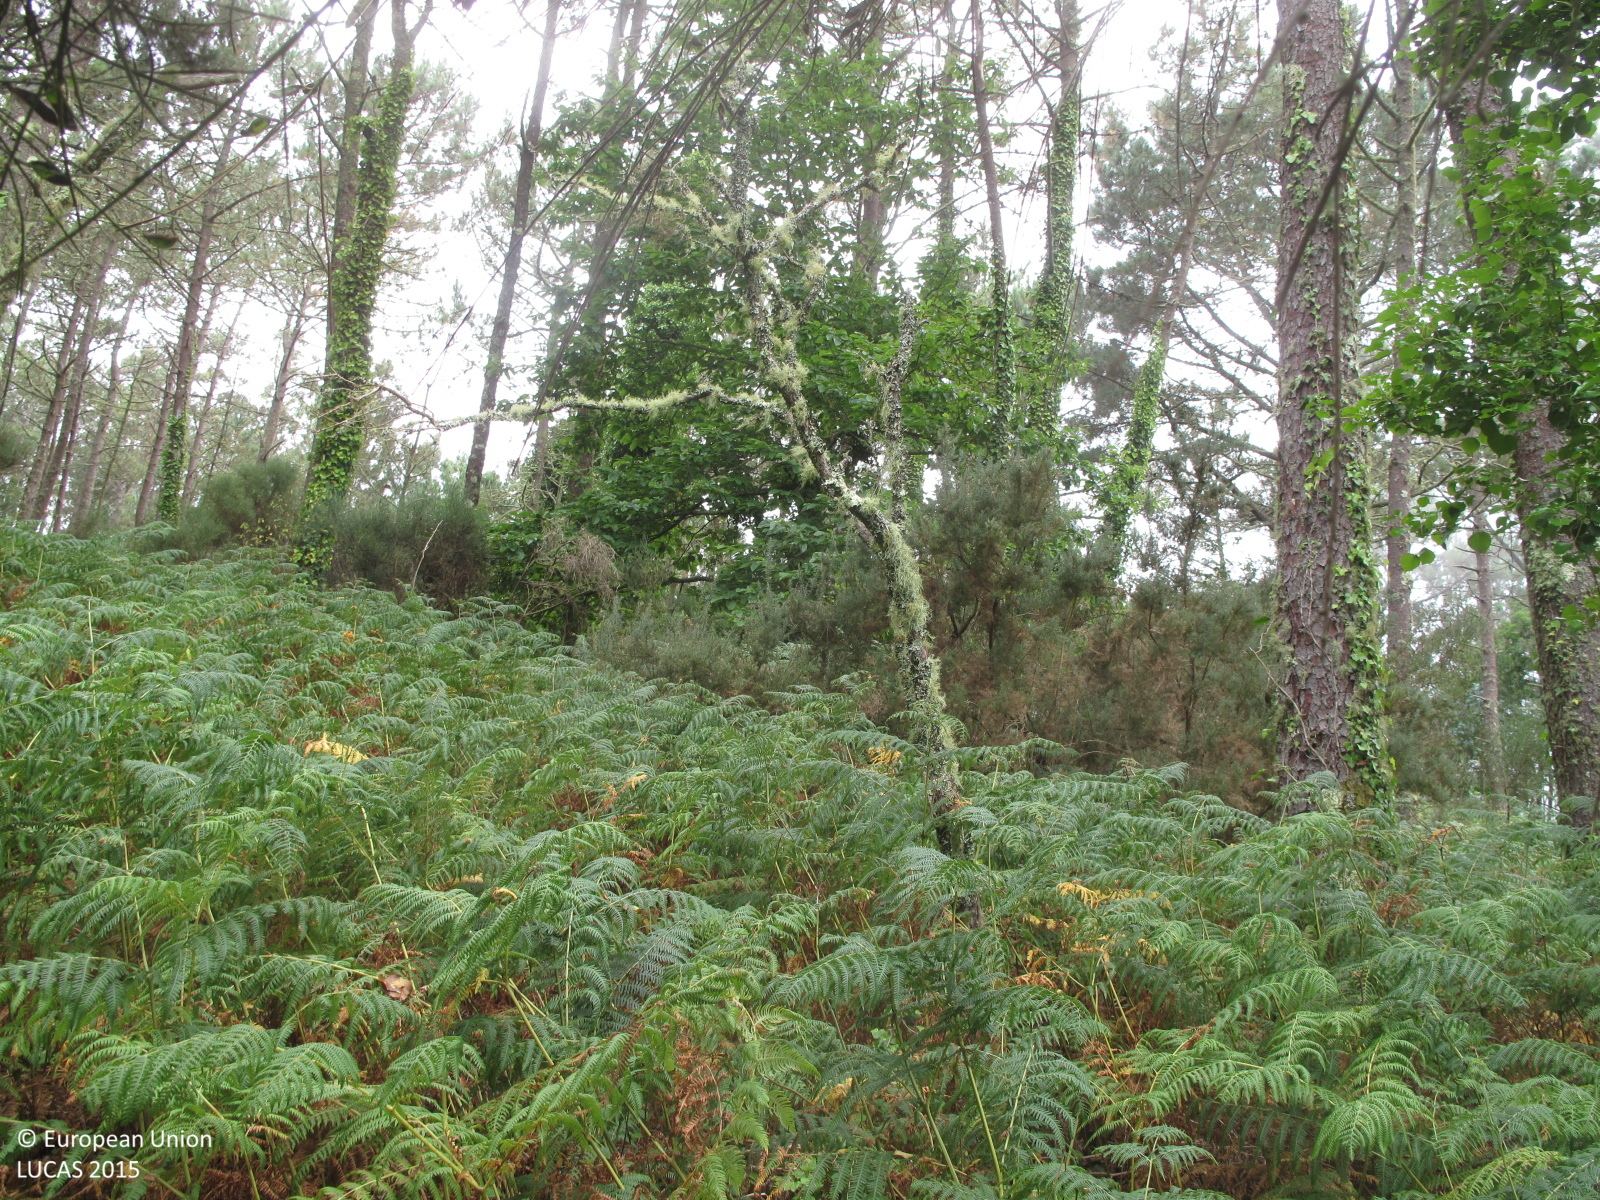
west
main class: Woodland
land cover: Pine dominated coniferous woodland
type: hemiboreal forest and nemoral coniferous forest and mixed broadleaved-coniferous forest
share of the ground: 50 - 75 %
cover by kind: coniferous forest trees 65 %, herbaceous plants 20 %, shrubs 10 %, broadleaved forest trees 5 %
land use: Forestry
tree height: > 5 m
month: July
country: ES
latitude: 42.9282
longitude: -9.2802
